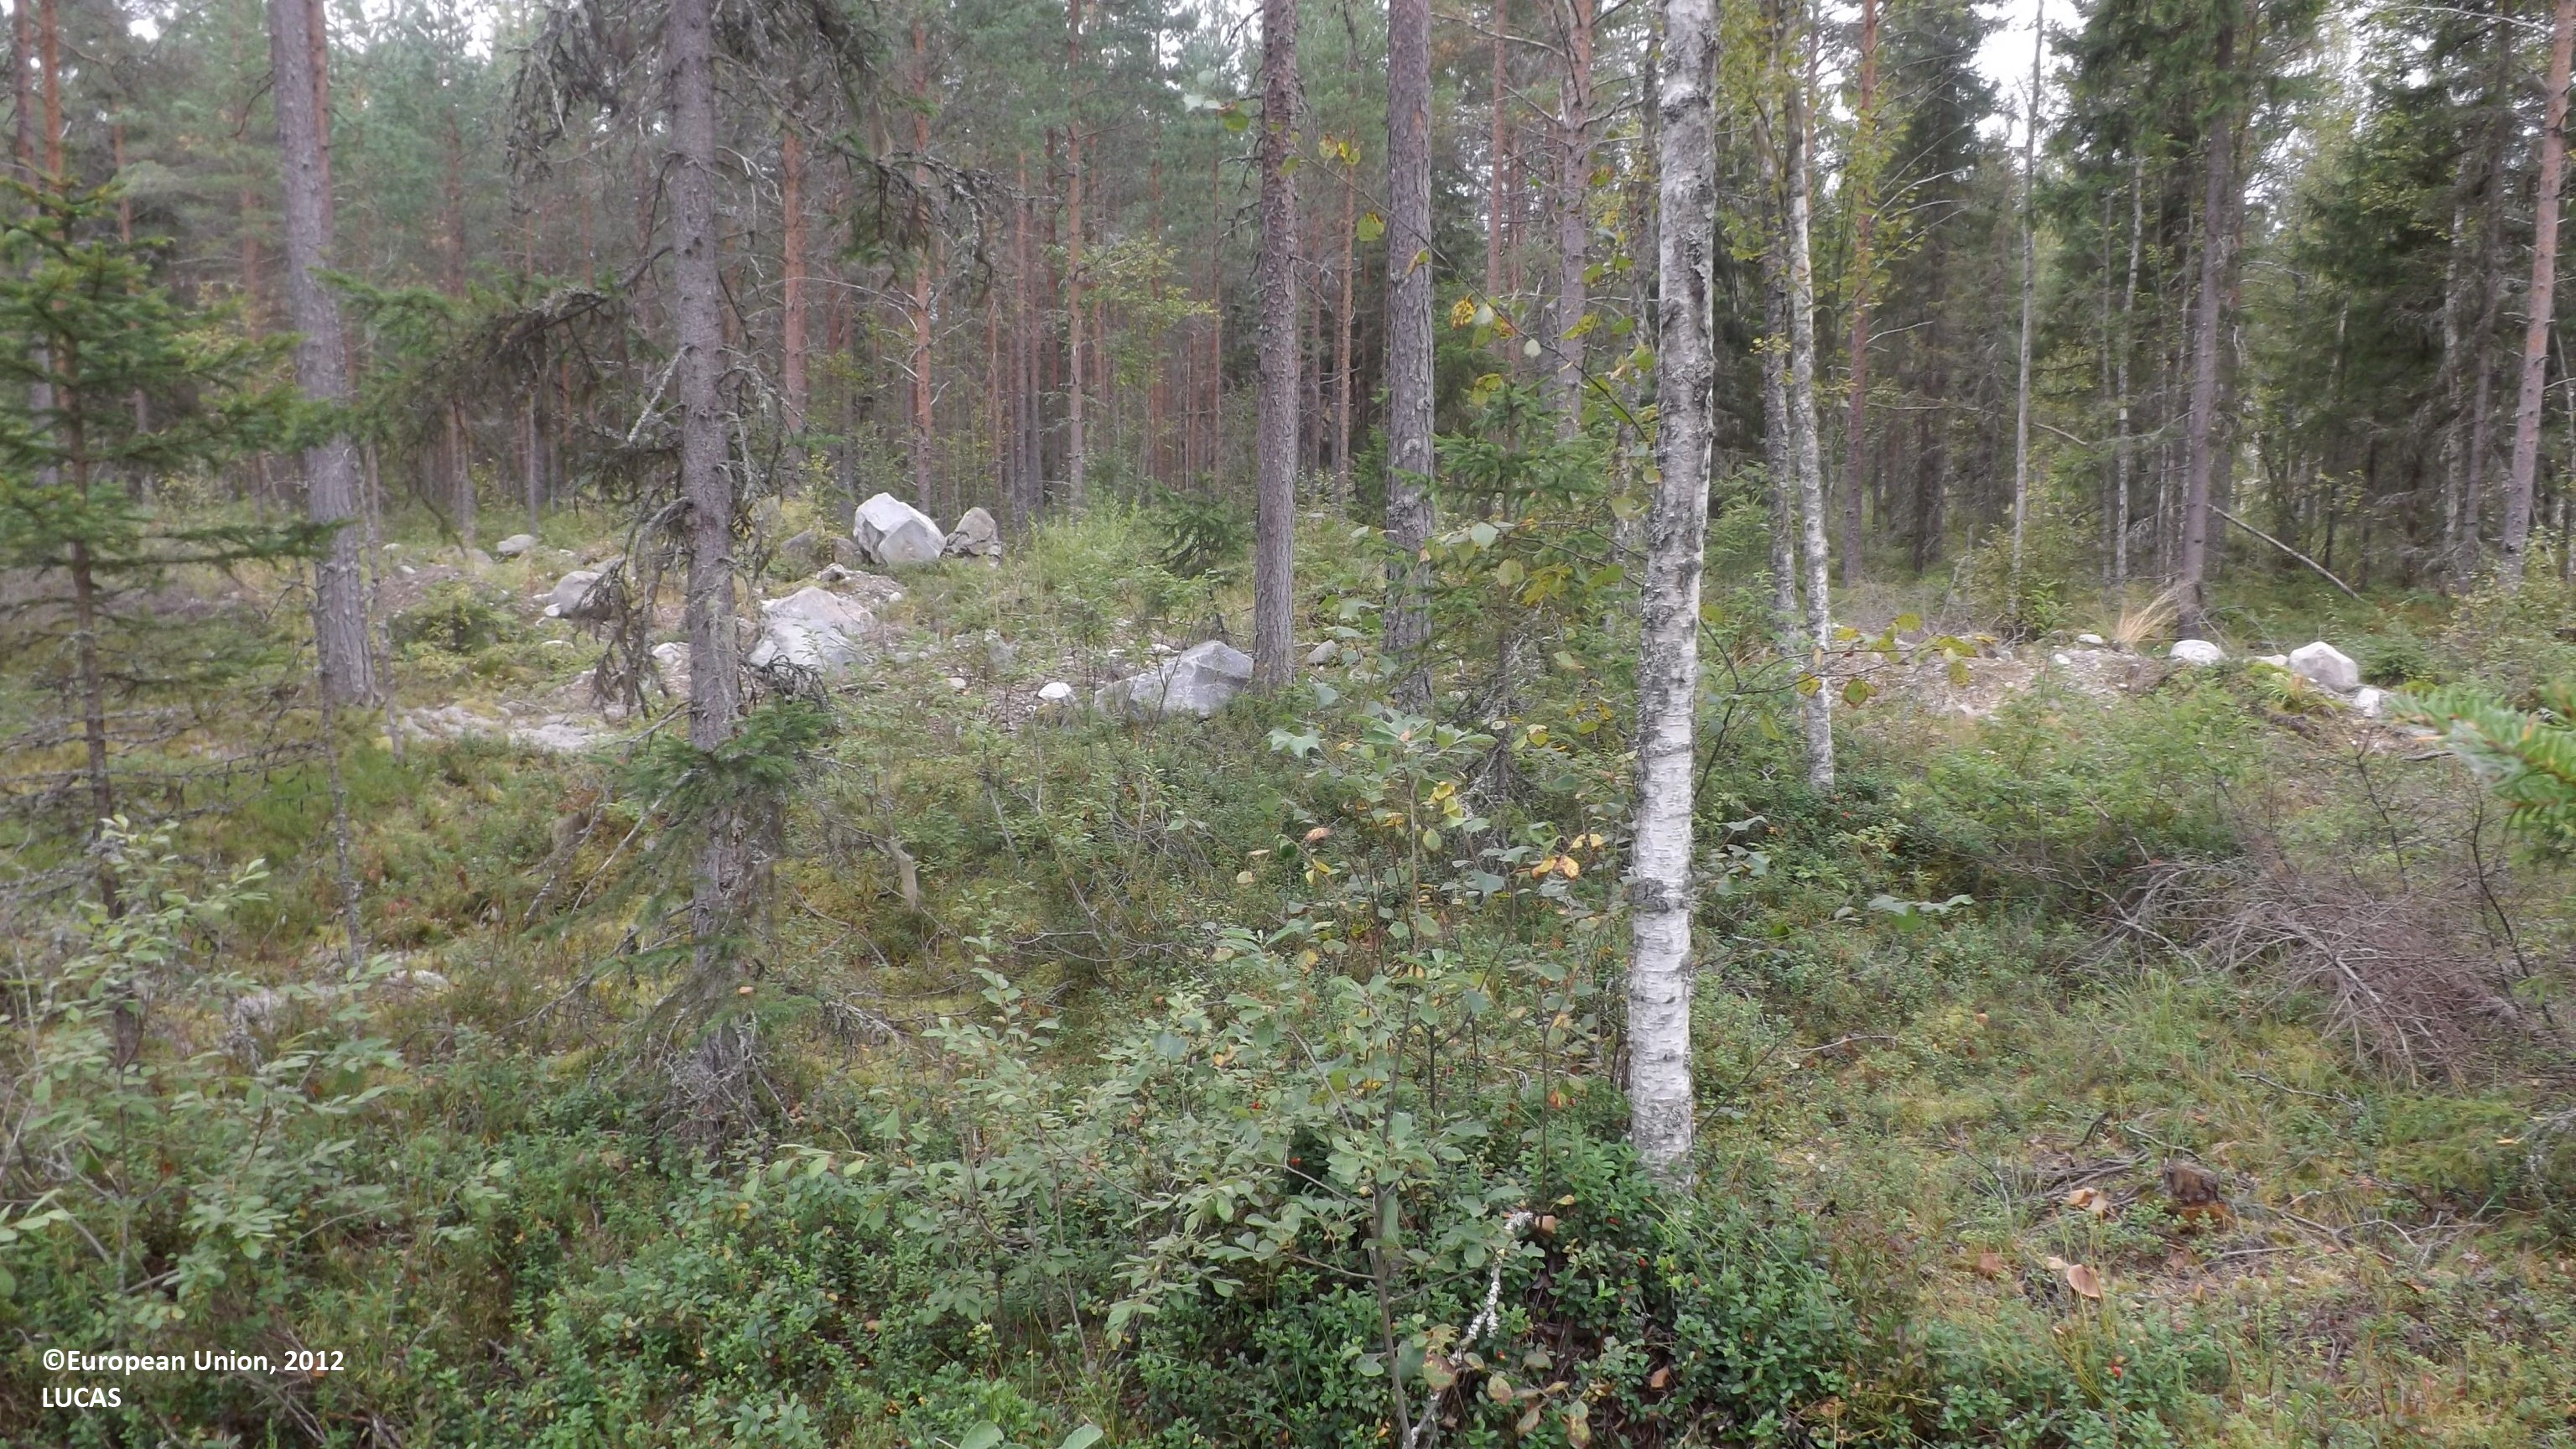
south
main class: Woodland
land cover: Other mixed woodland
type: boreal forest
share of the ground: 25 - 50 %
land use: Forestry
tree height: > 5 m
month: August
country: FI
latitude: 63.9639
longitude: 23.9294
